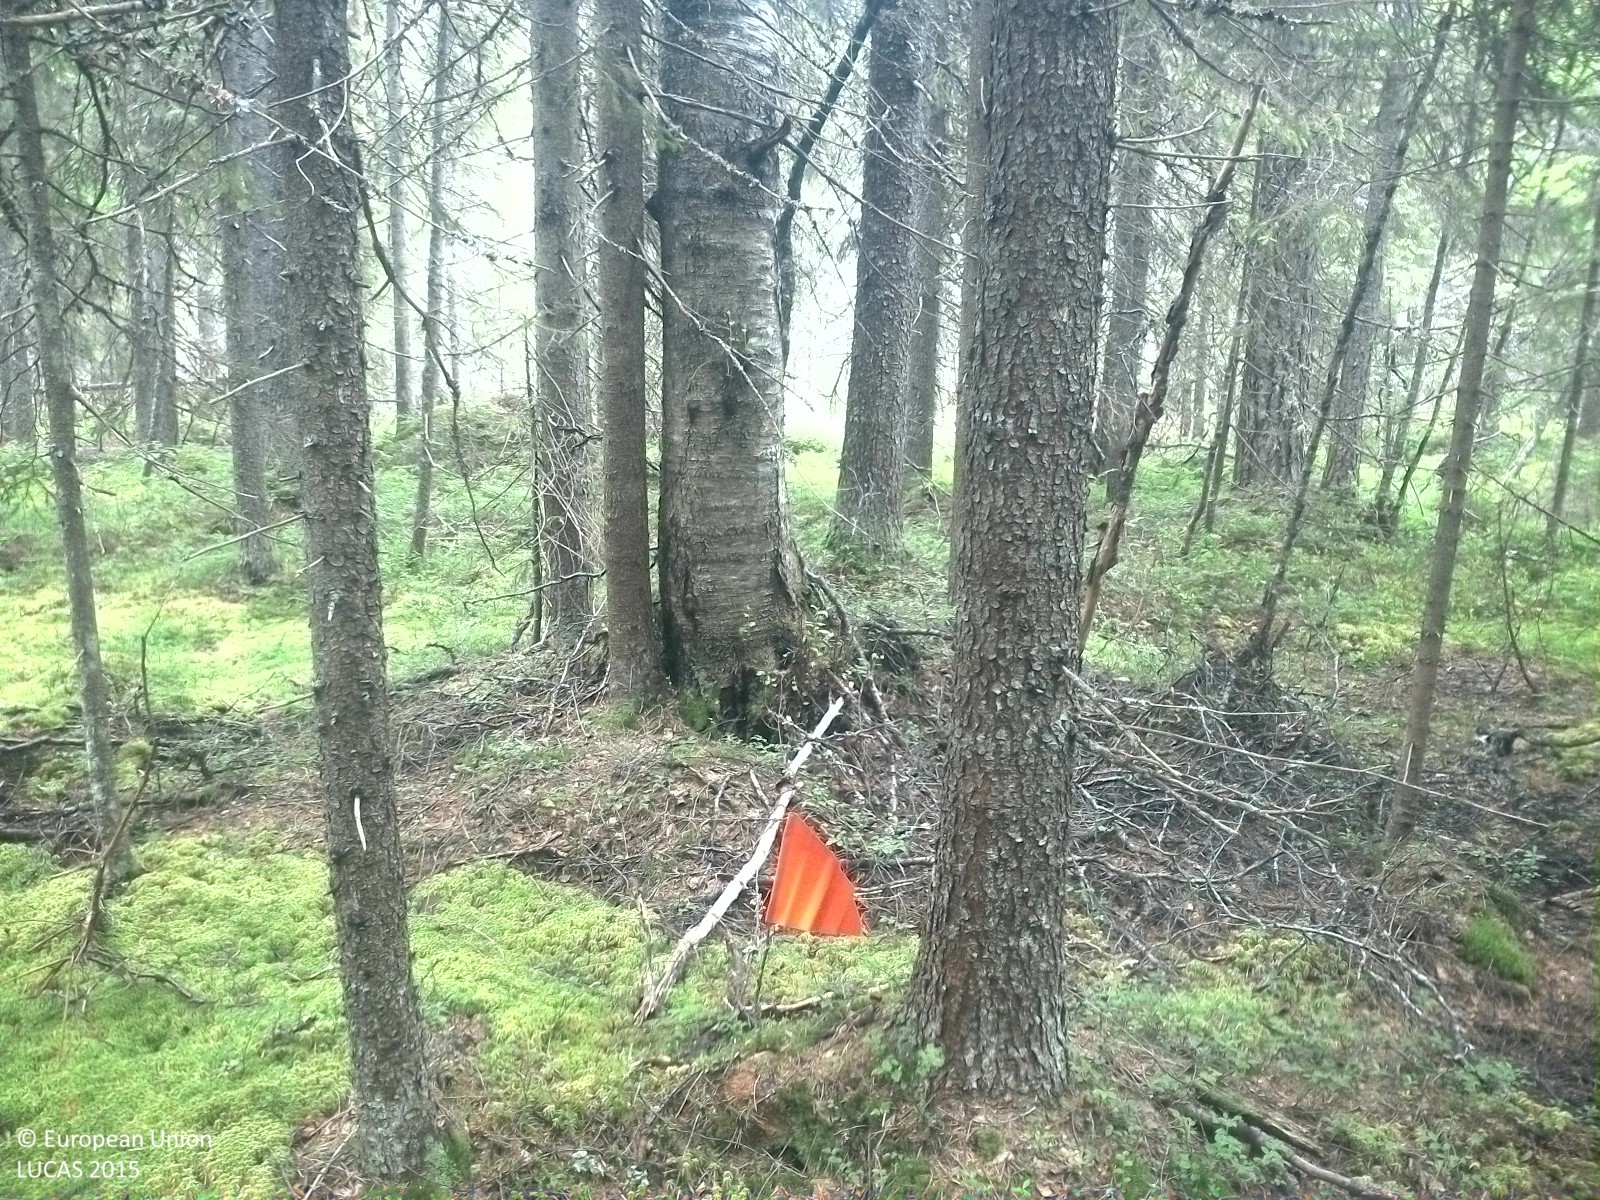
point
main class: Woodland
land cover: Spruce dominated coniferous woodland
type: boreal forest
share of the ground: 50 - 75 %
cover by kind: coniferous forest trees 60 %, lichens and mosses 30 %, herbaceous plants 10 %
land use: Forestry
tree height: > 5 m
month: July
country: SE
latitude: 62.5581
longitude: 17.7410
